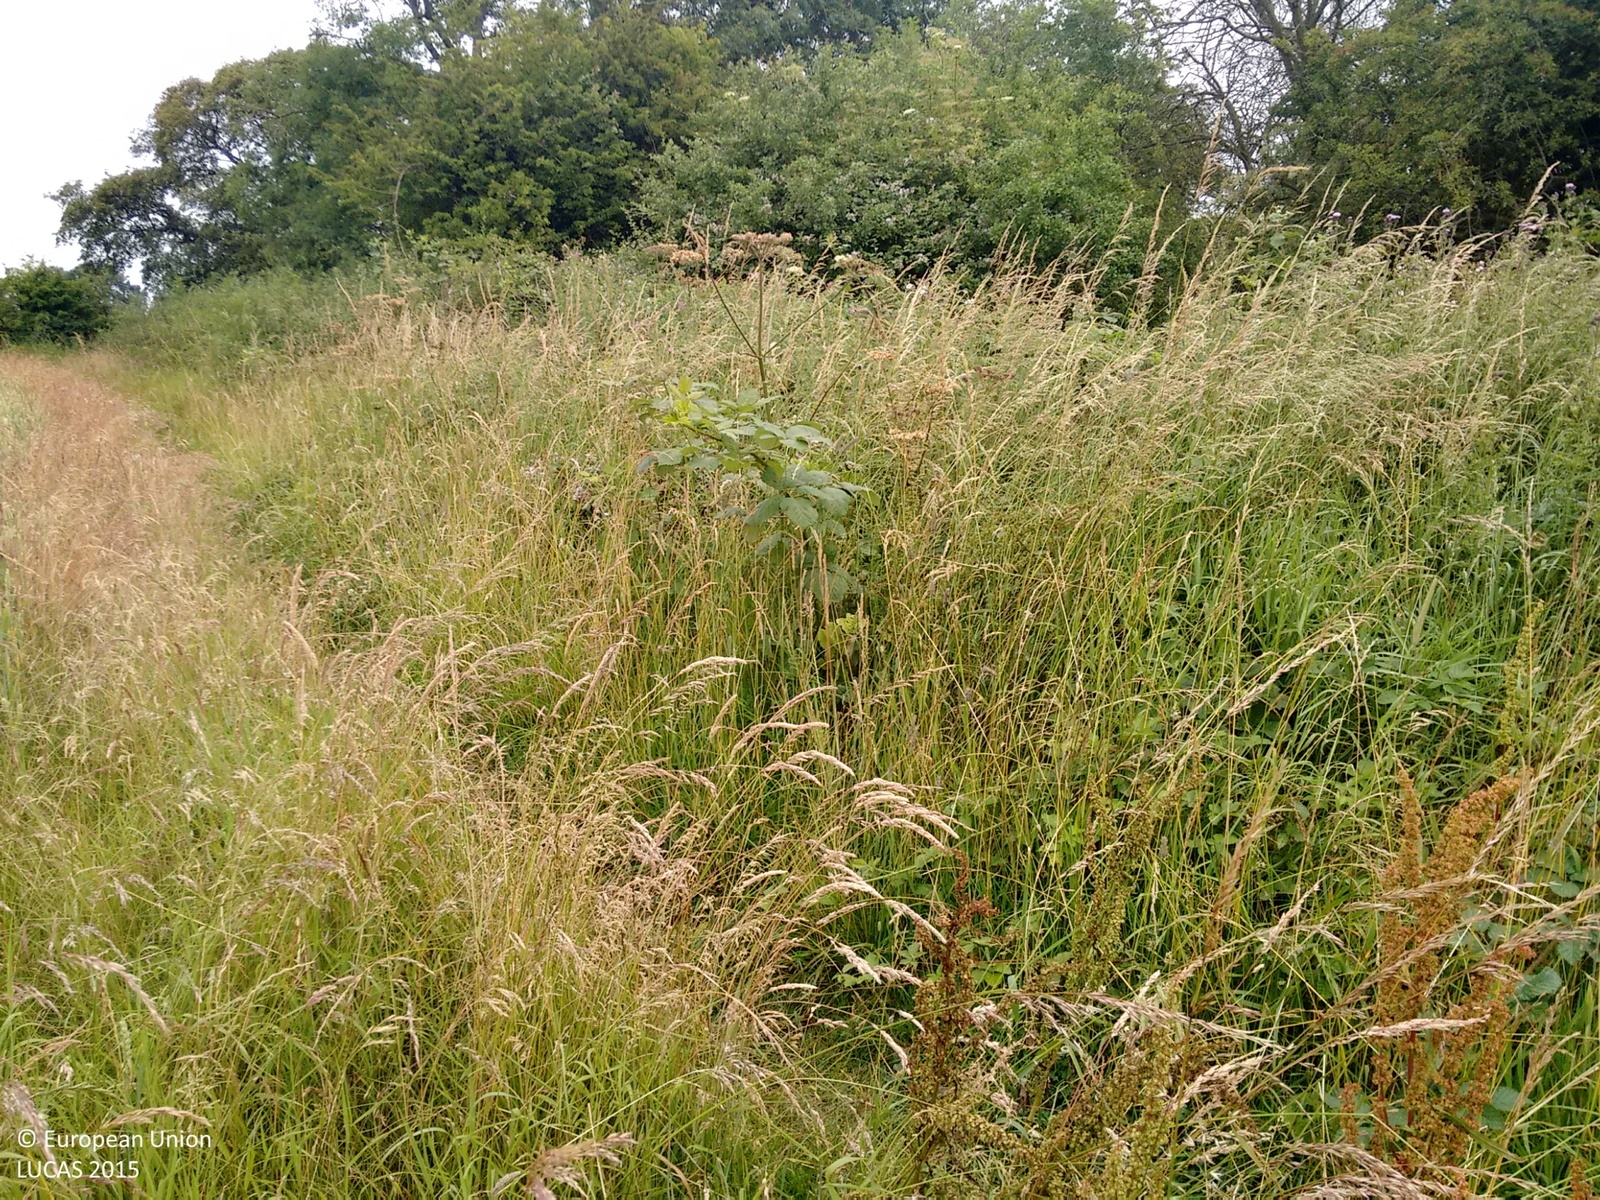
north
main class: Cropland
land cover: Common wheat
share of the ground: > 75 %
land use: Agriculture (excluding fallow land and kitchen gardens)
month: July
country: GB
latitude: 52.9200
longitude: -1.5482
